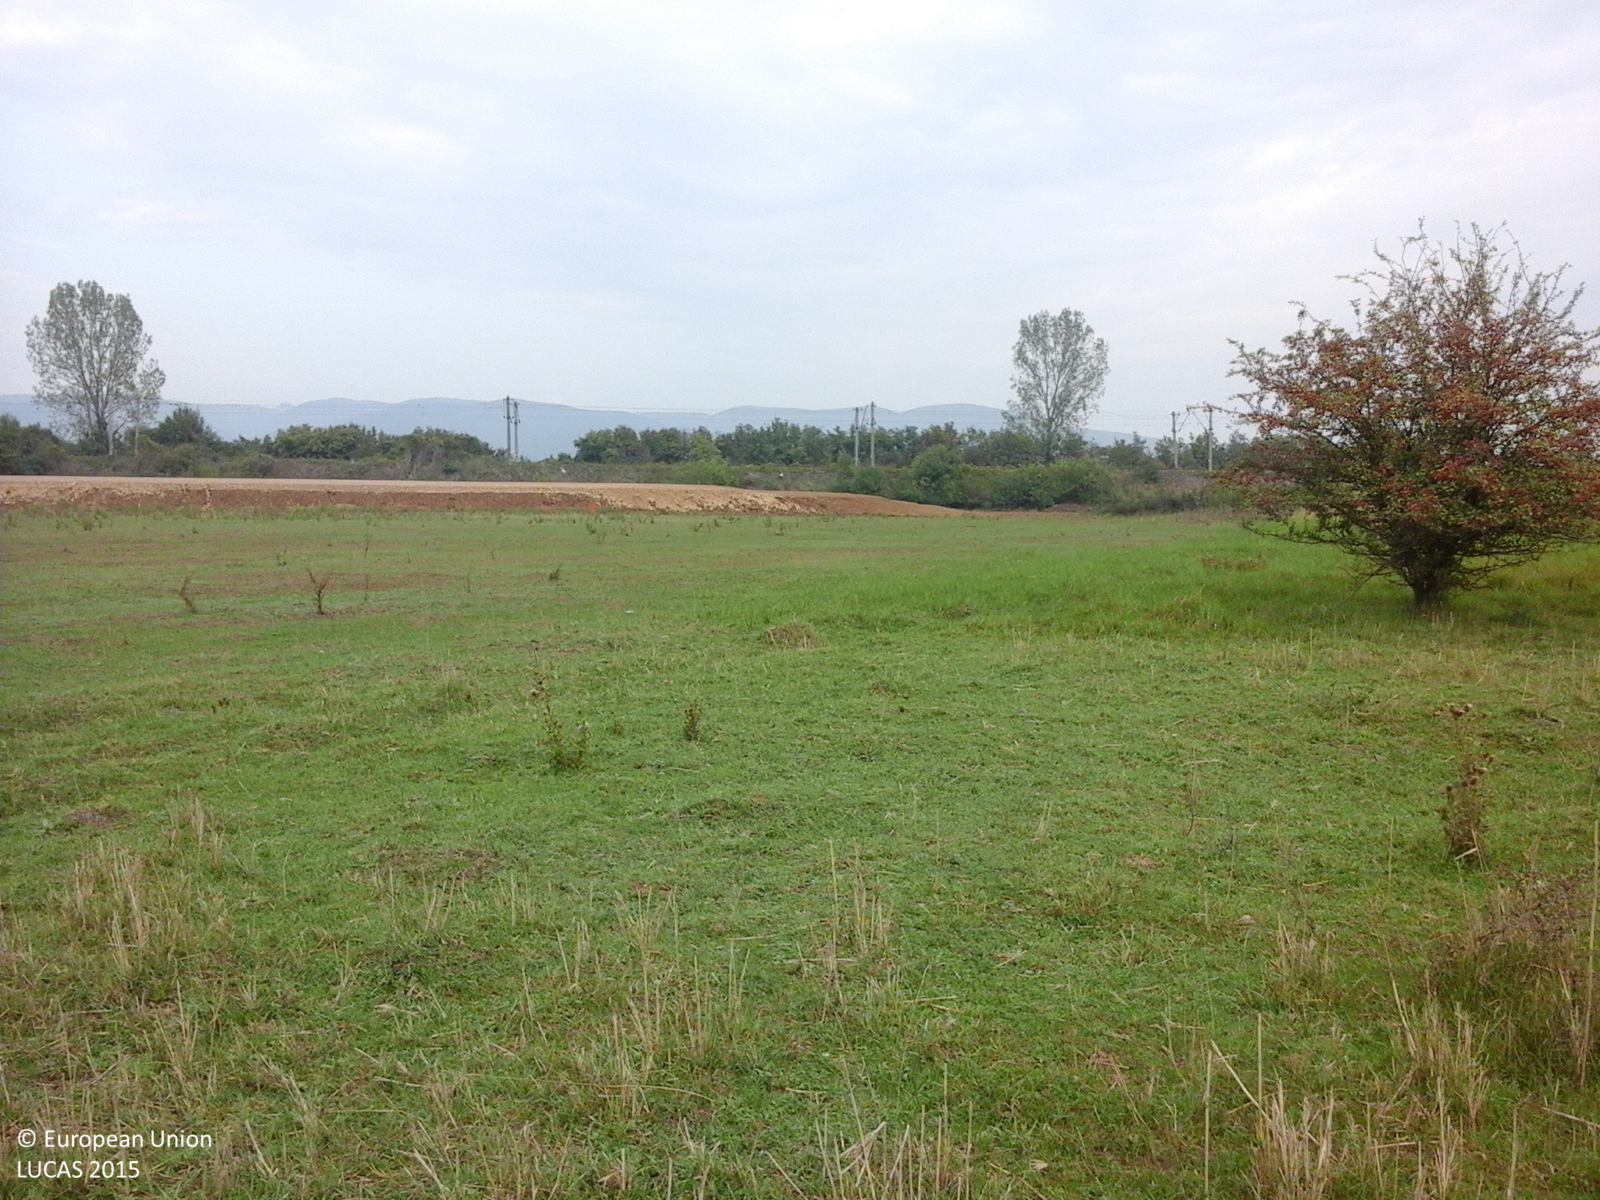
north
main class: Grassland
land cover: Spontaneously vegetated surfaces
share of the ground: > 75 %
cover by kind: herbaceous plants 100 %
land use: Fallow land
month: September
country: RO
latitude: 45.8449
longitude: 23.1530
